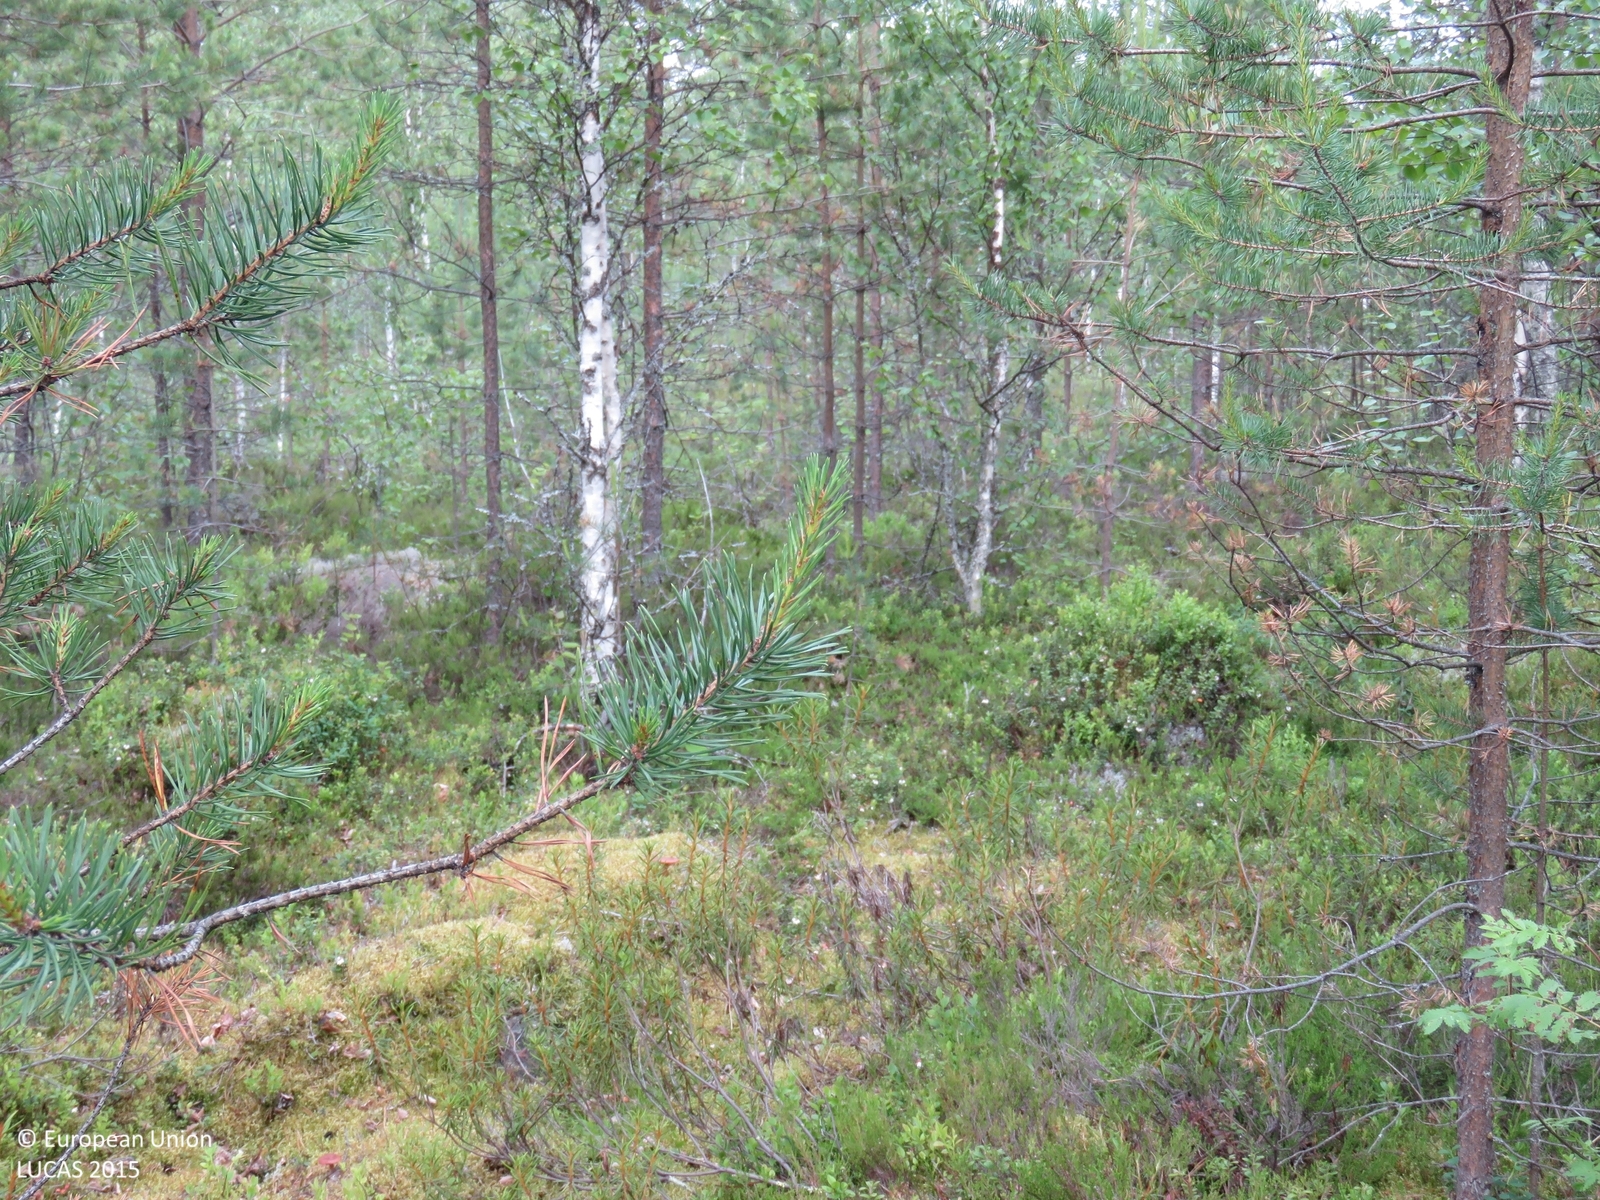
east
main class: Woodland
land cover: Pine dominated mixed woodland
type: boreal forest
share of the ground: > 75 %
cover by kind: coniferous forest trees 45 %, broadleaved forest trees 35 %, shrubs 10 %, herbaceous plants 5 %, lichens and mosses 5 %
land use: Forestry
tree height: > 5 m
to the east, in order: Pine dominated mixed woodland; Ditches and canals; Pine dominated coniferous woodland; Ditches and canals; Other mixed woodland; Ditches and canals; Pine dominated coniferous woodland
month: July
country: FI
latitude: 64.4813
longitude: 26.4019
